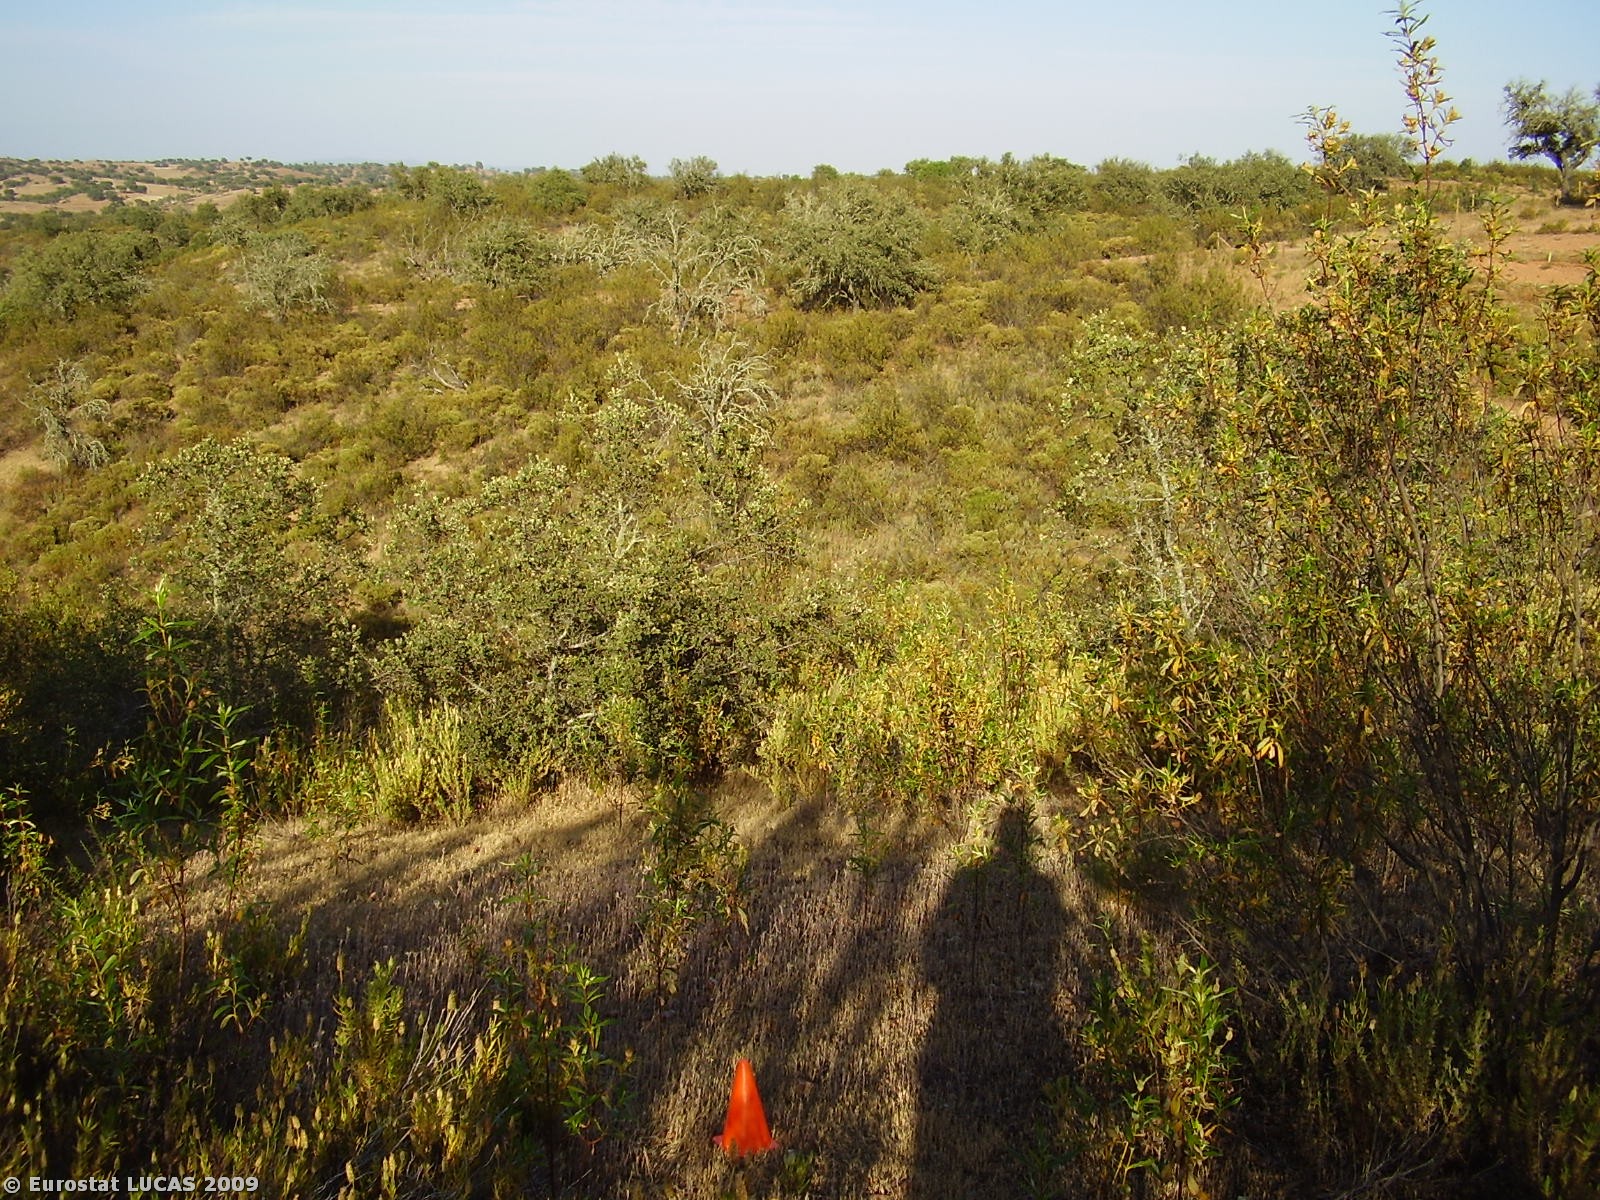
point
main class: Shrubland
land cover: Shrubland with sparse tree cover
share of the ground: 50 - 75 %
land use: Fallow land
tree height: > 5 m
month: May
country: PT
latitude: 37.7776
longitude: -7.4879
